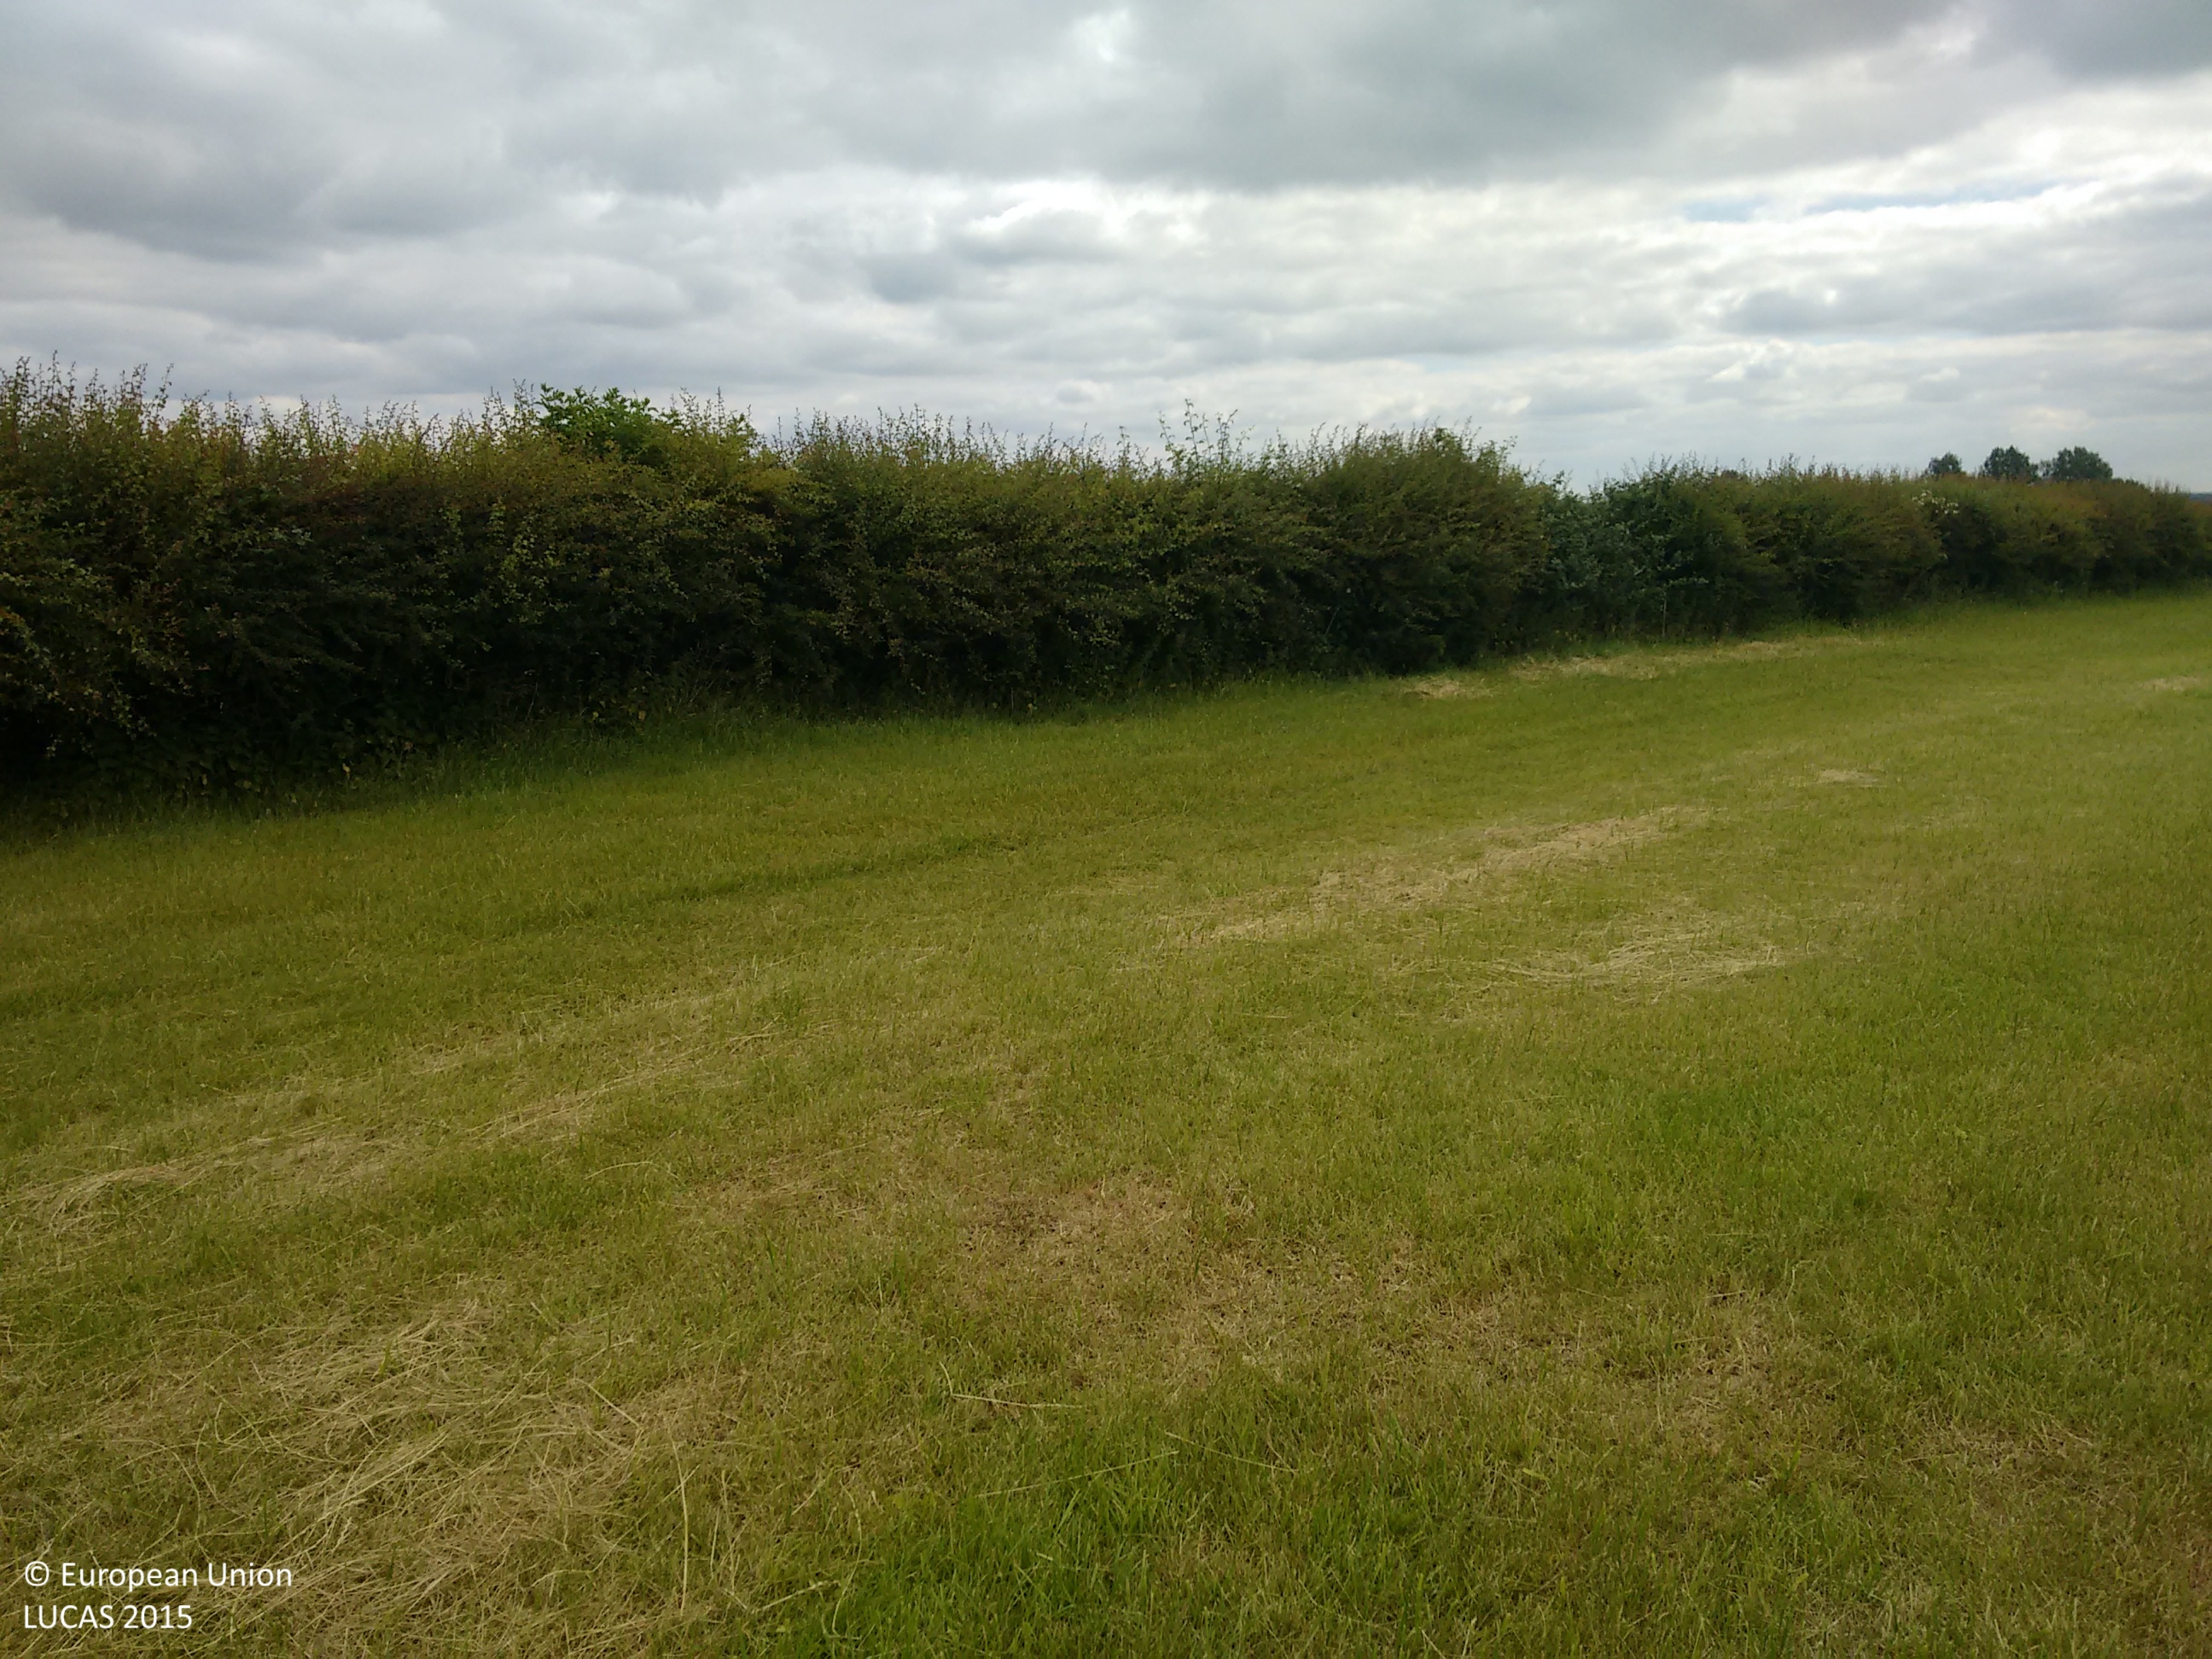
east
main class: Grassland
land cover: Grassland without tree/shrub cover
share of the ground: > 75 %
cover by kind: herbaceous plants 100 %
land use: Agriculture (excluding fallow land and kitchen gardens)
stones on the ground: < 10 %
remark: Harvested field
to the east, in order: Grassland without tree/shrub cover; Fences; Managed hedges; Fences; Grassland without tree/shrub cover
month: June
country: GB
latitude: 50.9007
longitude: -0.0292
